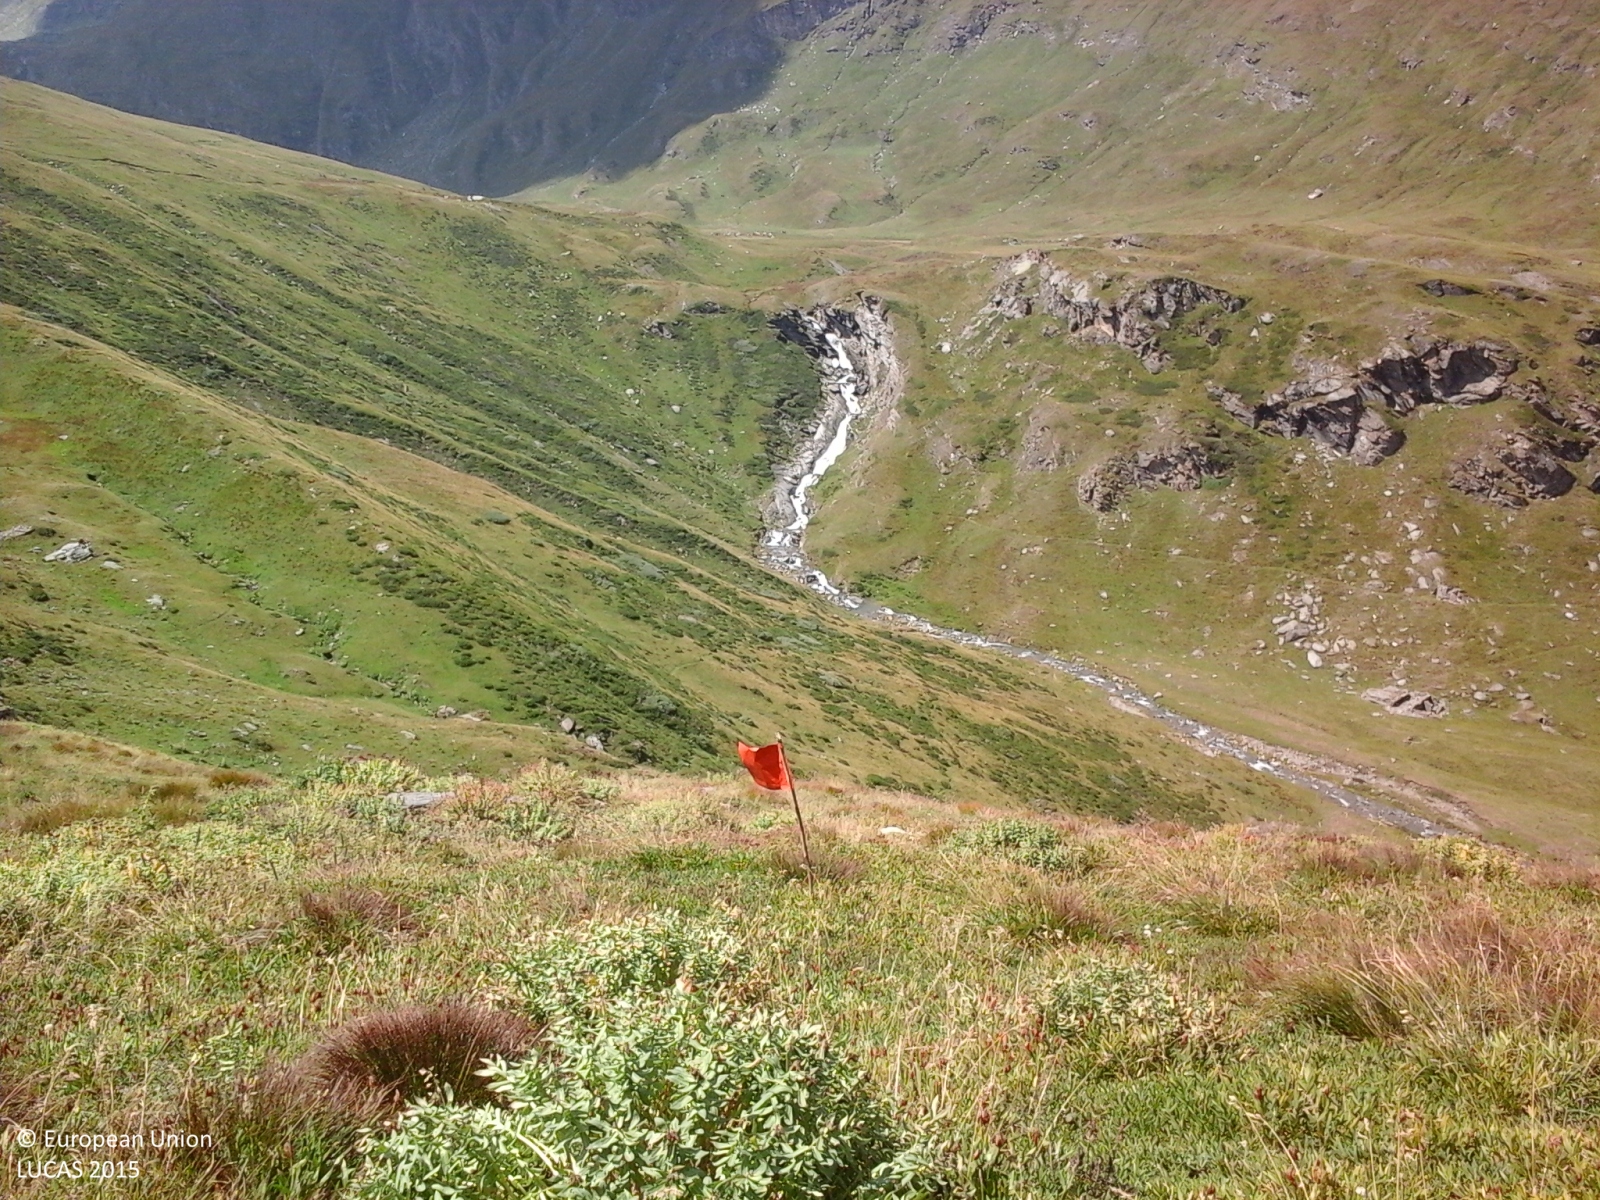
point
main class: Grassland
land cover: Grassland without tree/shrub cover
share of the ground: > 75 %
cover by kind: herbaceous plants 100 %
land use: Agriculture (excluding fallow land and kitchen gardens)
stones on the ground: < 10 %
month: August
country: IT
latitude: 45.6023
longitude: 7.5548
